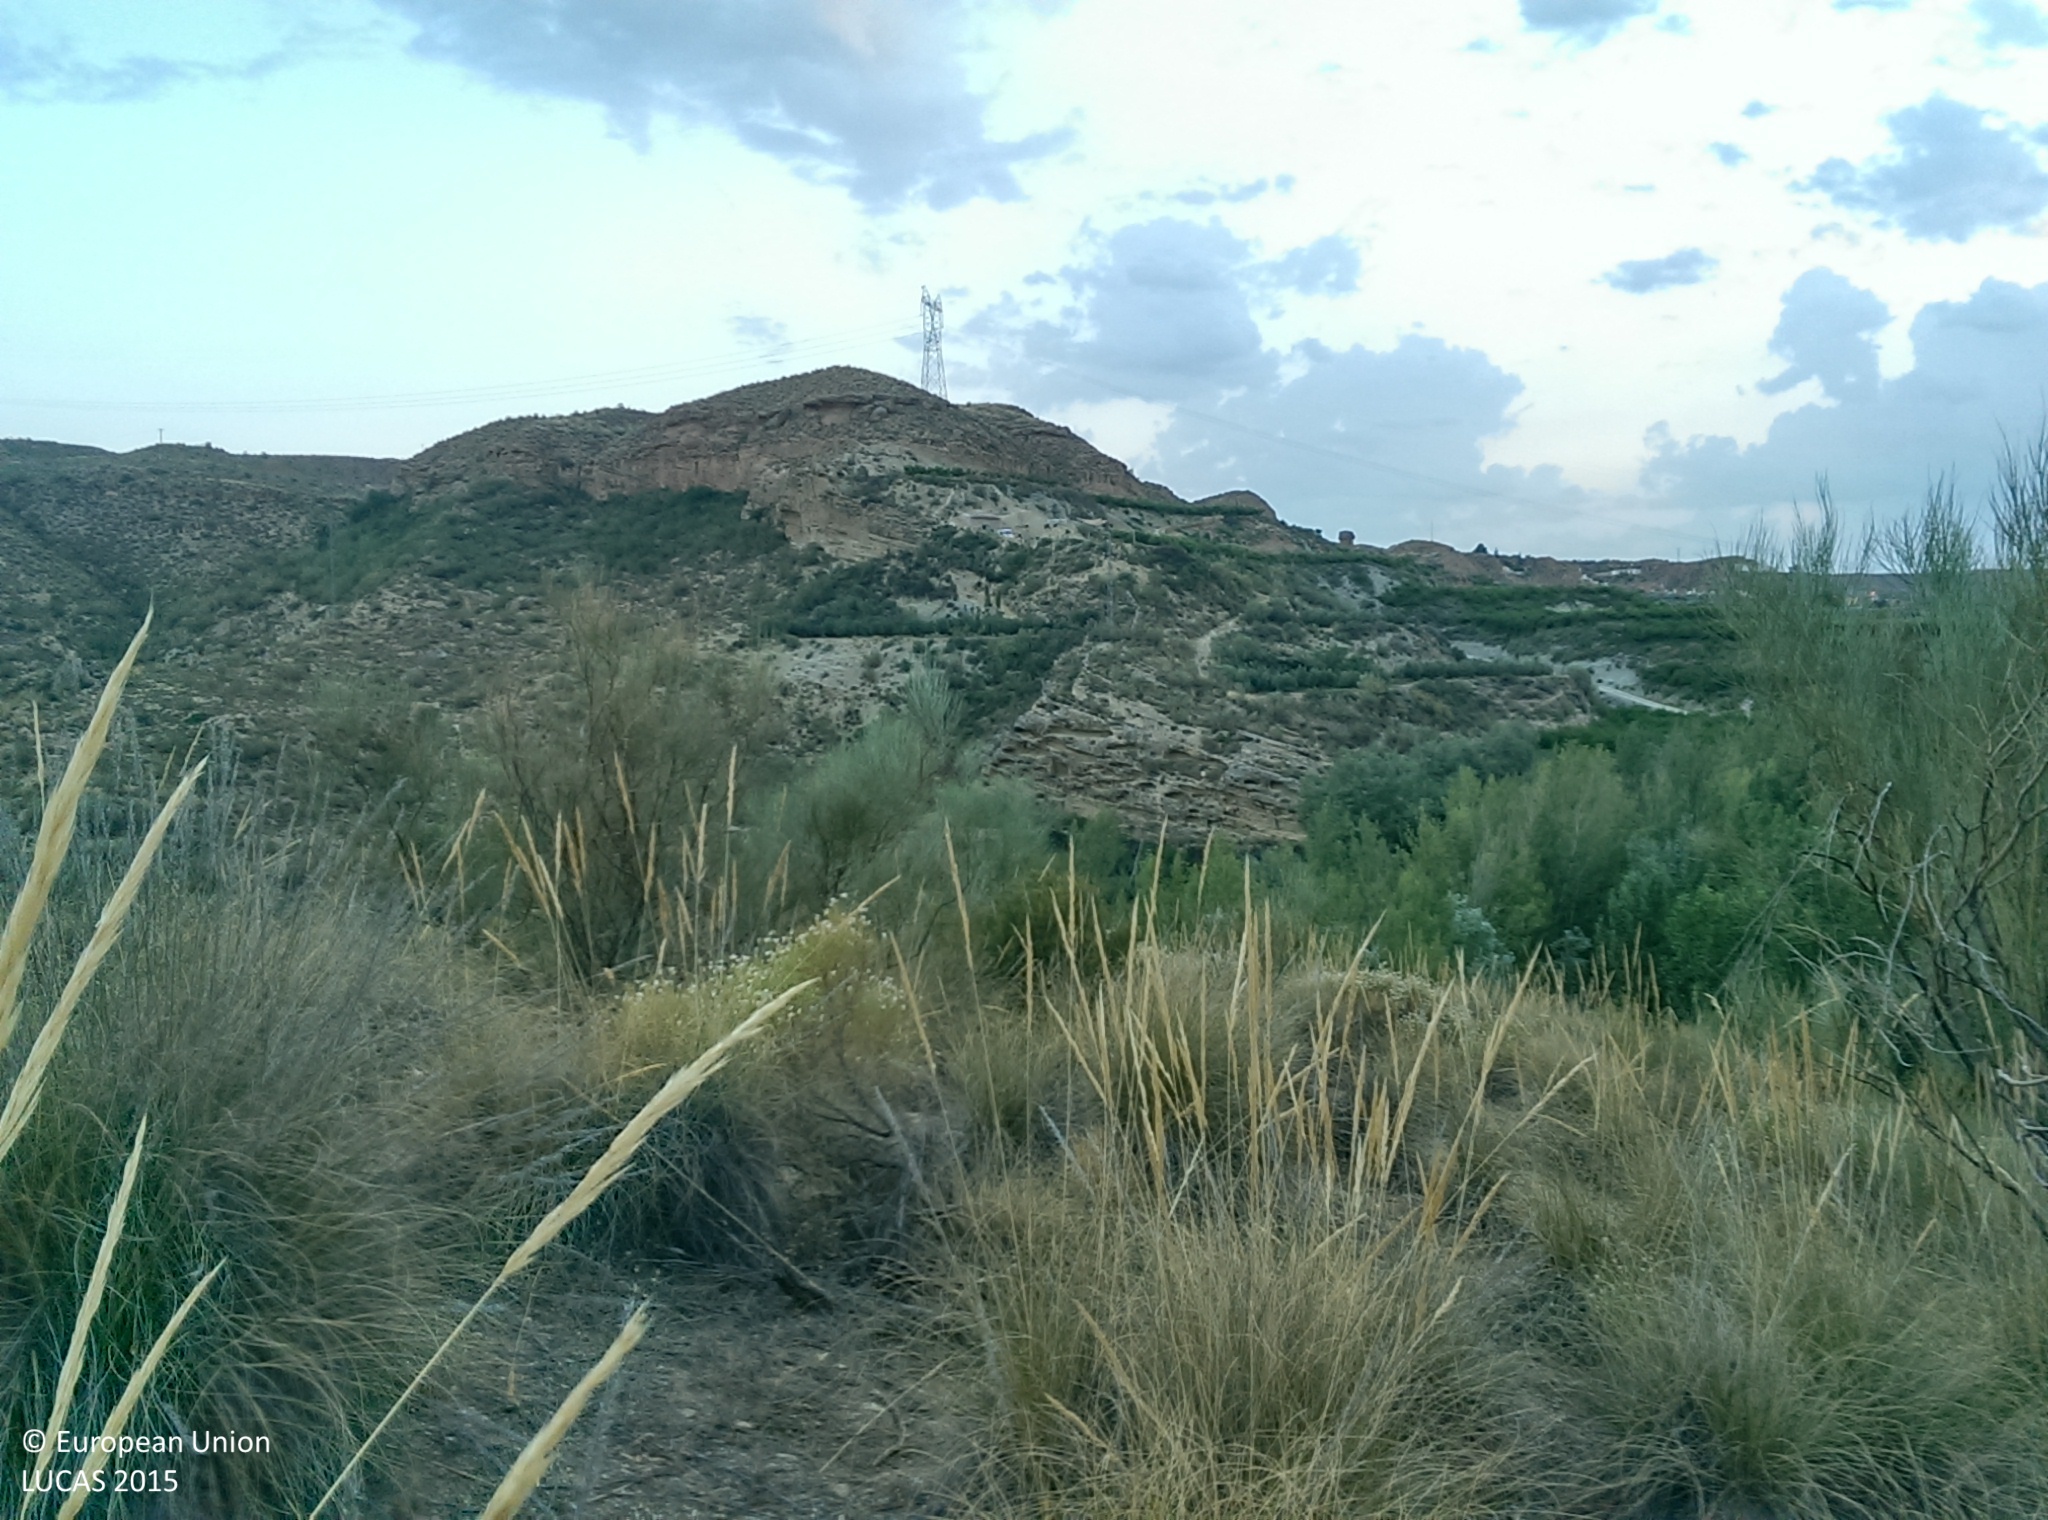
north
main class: Grassland
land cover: Grassland without tree/shrub cover
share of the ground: > 75 %
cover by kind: herbaceous plants 75 %, unconsolidated bare surface 20 %, shrubs 5 %
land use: Semi-natural and natural areas not in use
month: July
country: ES
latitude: 37.3120
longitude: -3.2461
